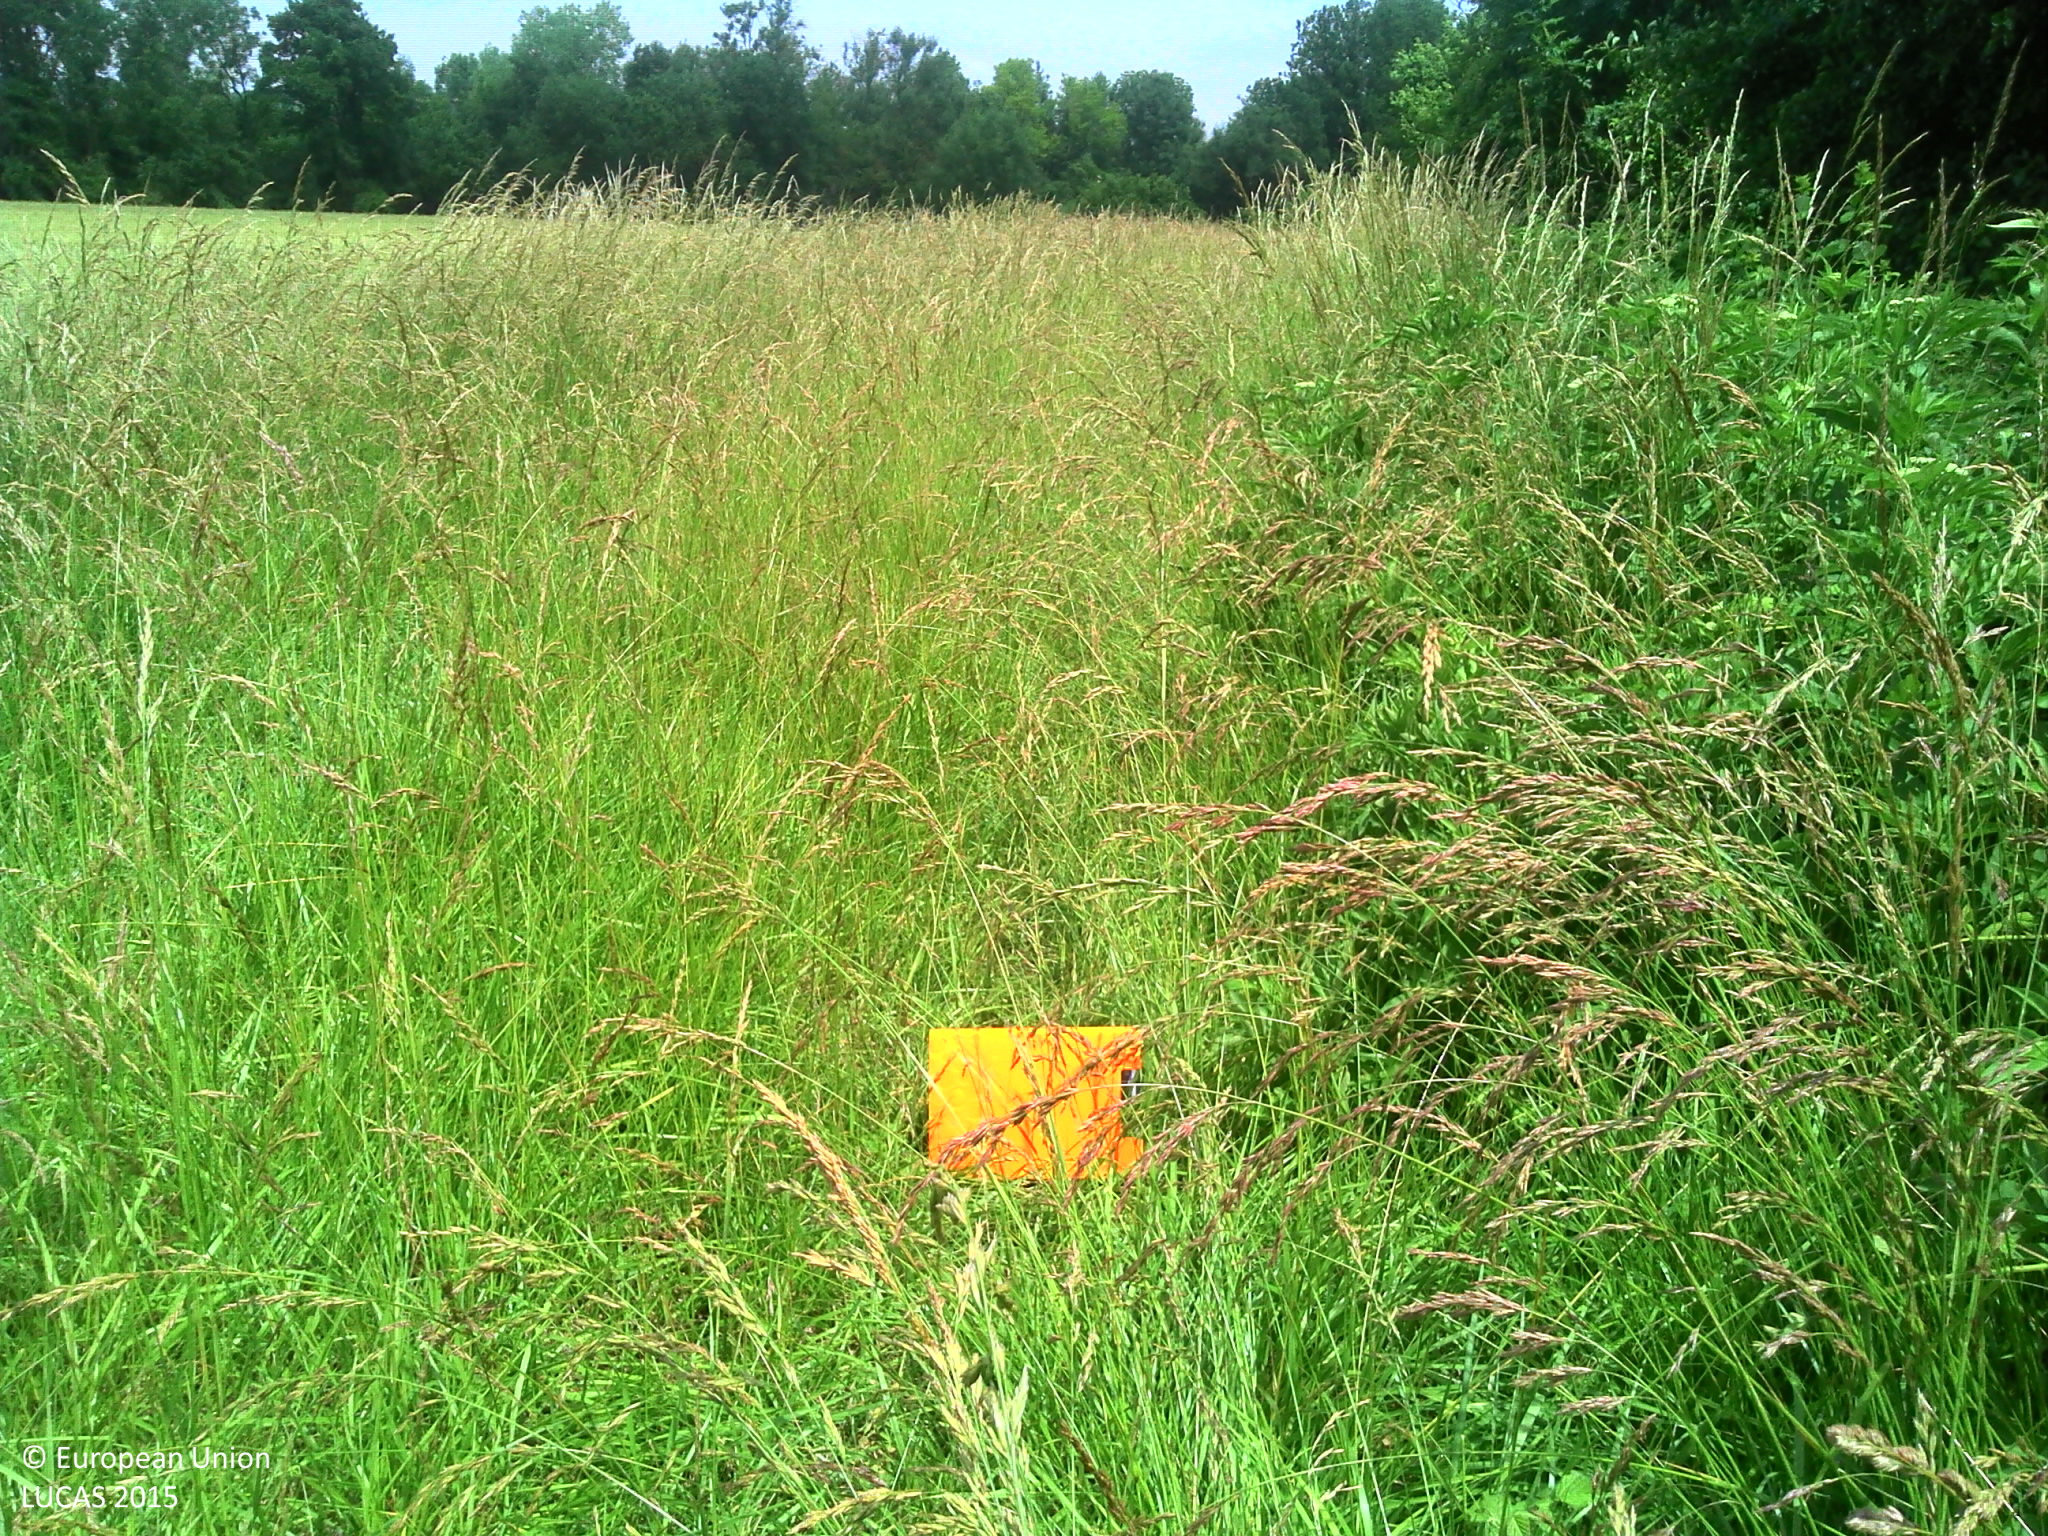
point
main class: Grassland
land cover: Grassland without tree/shrub cover
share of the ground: > 75 %
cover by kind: herbaceous plants 100 %
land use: Agriculture (excluding fallow land and kitchen gardens)
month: June
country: FR
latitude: 49.3786
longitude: 3.6991
